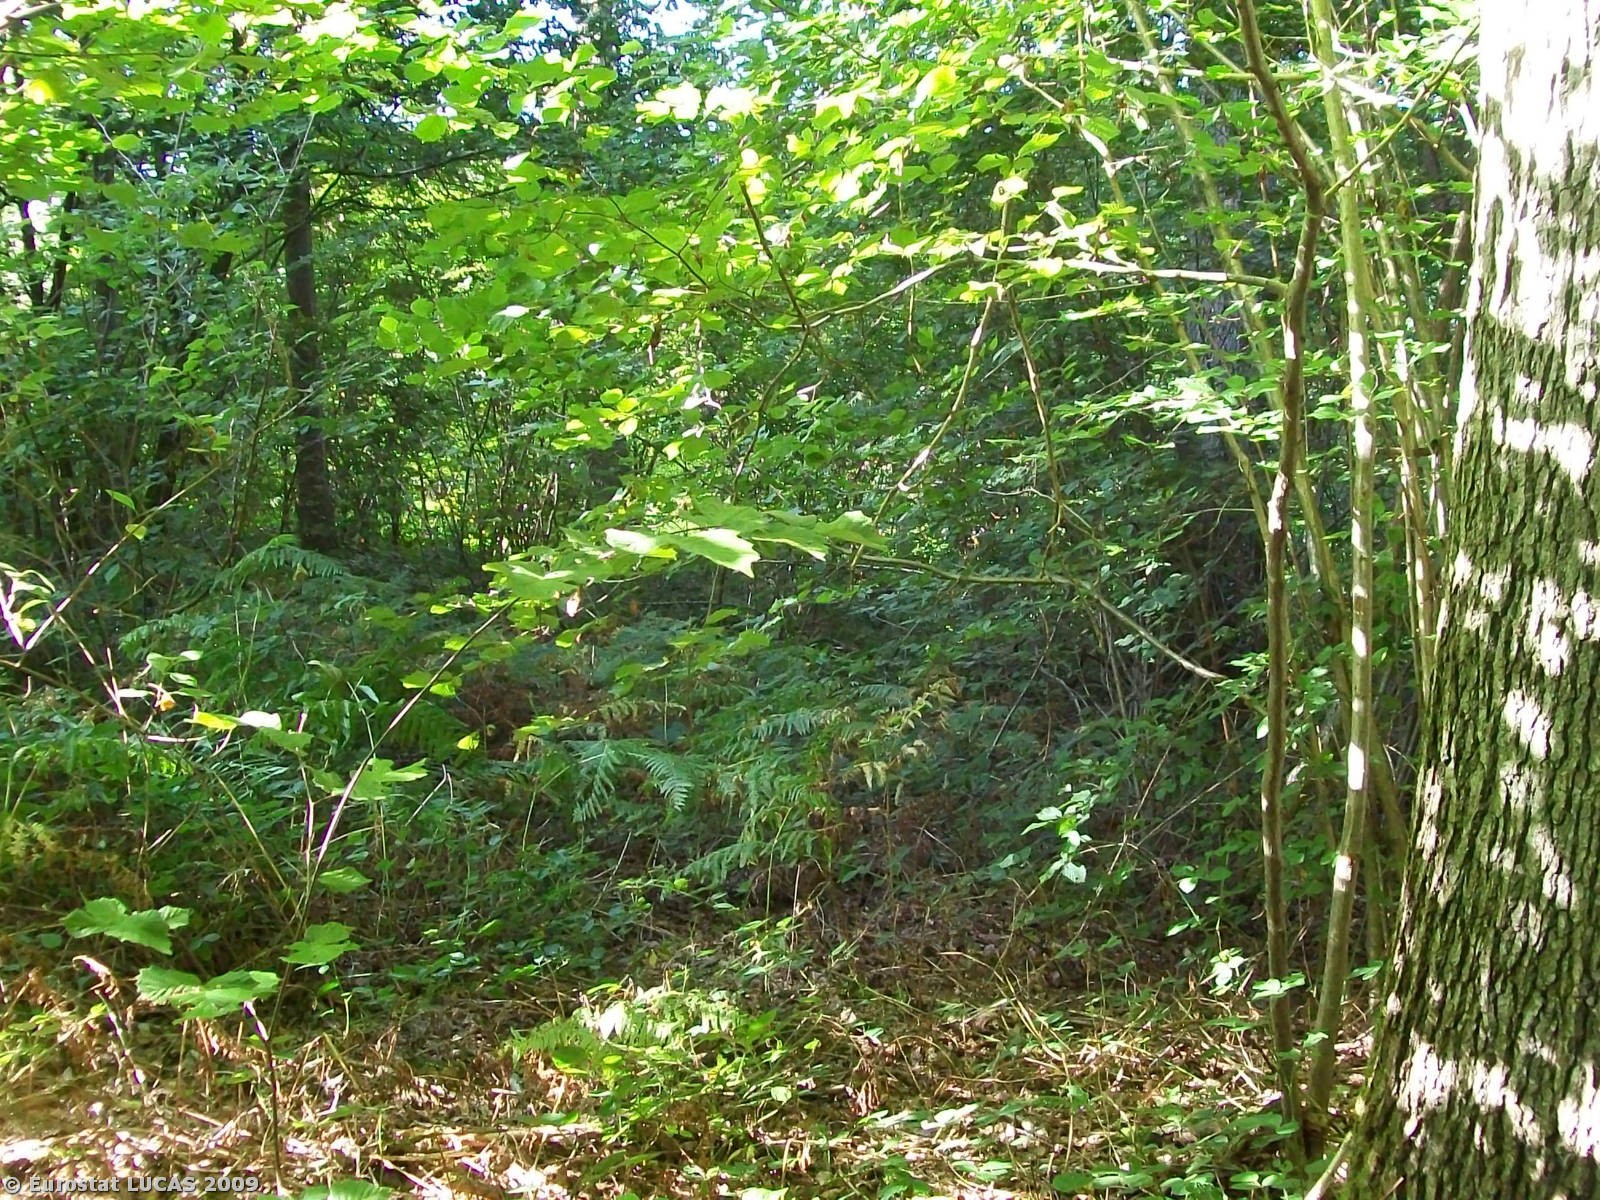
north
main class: Woodland
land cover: Broadleaved woodland
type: mesophytic deciduous forest
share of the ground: > 75 %
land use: Community services
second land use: Forestry
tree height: > 5 m
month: August
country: GB
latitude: 51.9556
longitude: -2.4488
